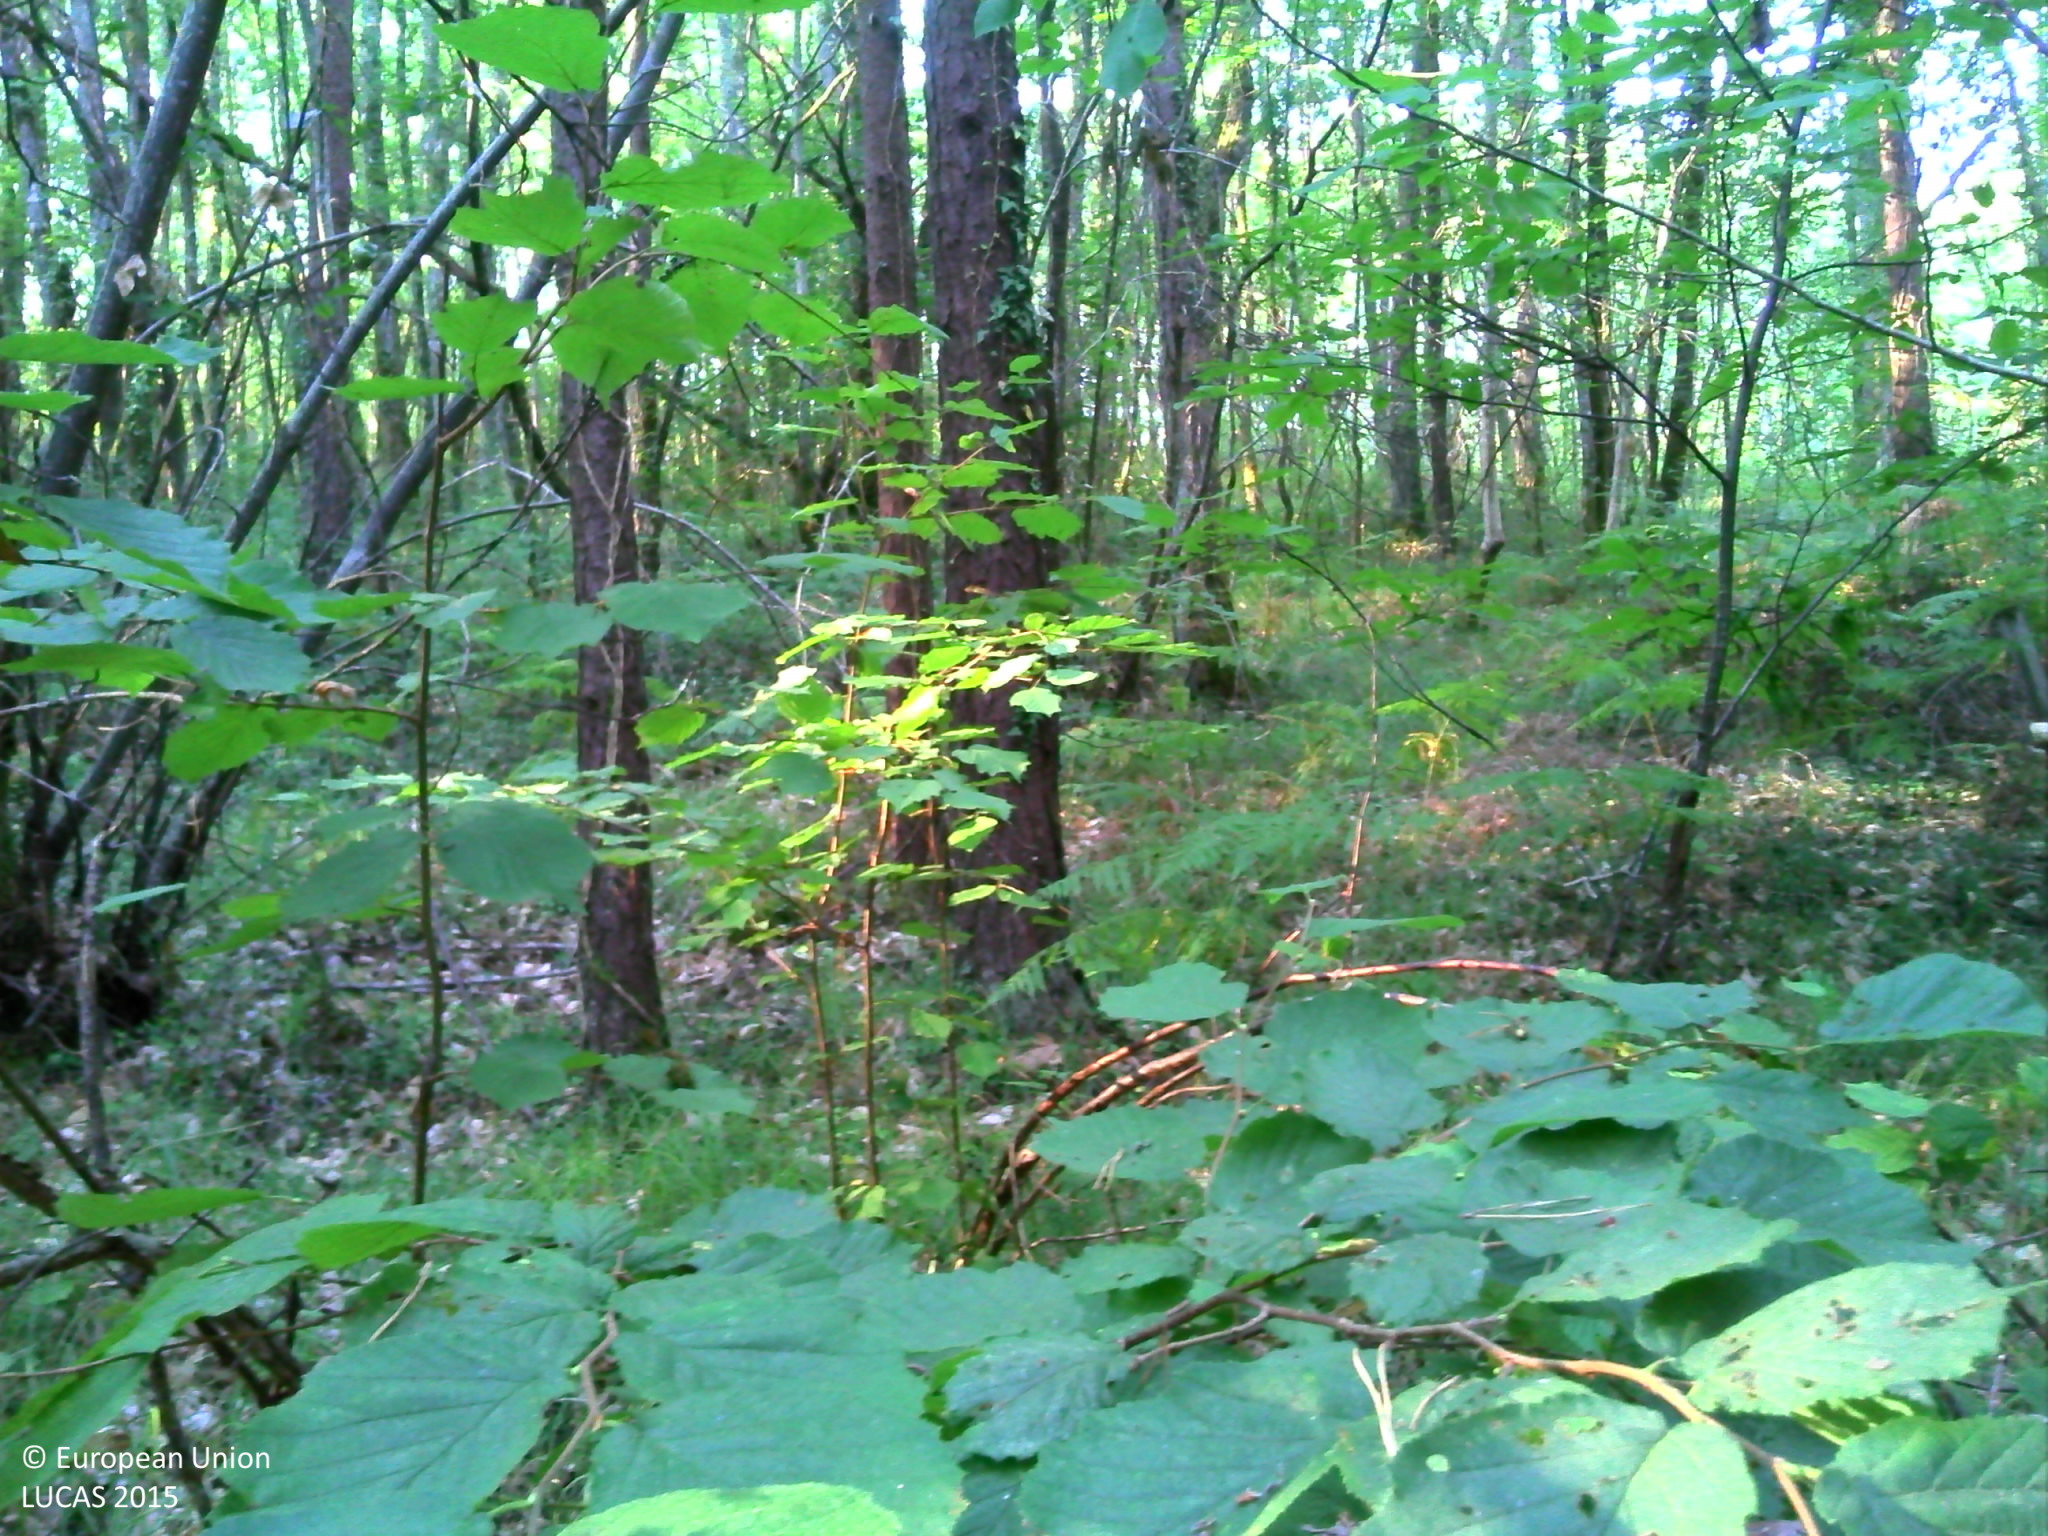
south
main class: Woodland
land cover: Pine dominated mixed woodland
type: mesophytic deciduous forest
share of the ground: > 75 %
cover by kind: broadleaved forest trees 60 %, coniferous forest trees 20 %, herbaceous plants 10 %, shrubs 5 %, lichens and mosses 5 %
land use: Forestry
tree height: > 5 m
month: August
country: FR
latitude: 44.8297
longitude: 0.7970
